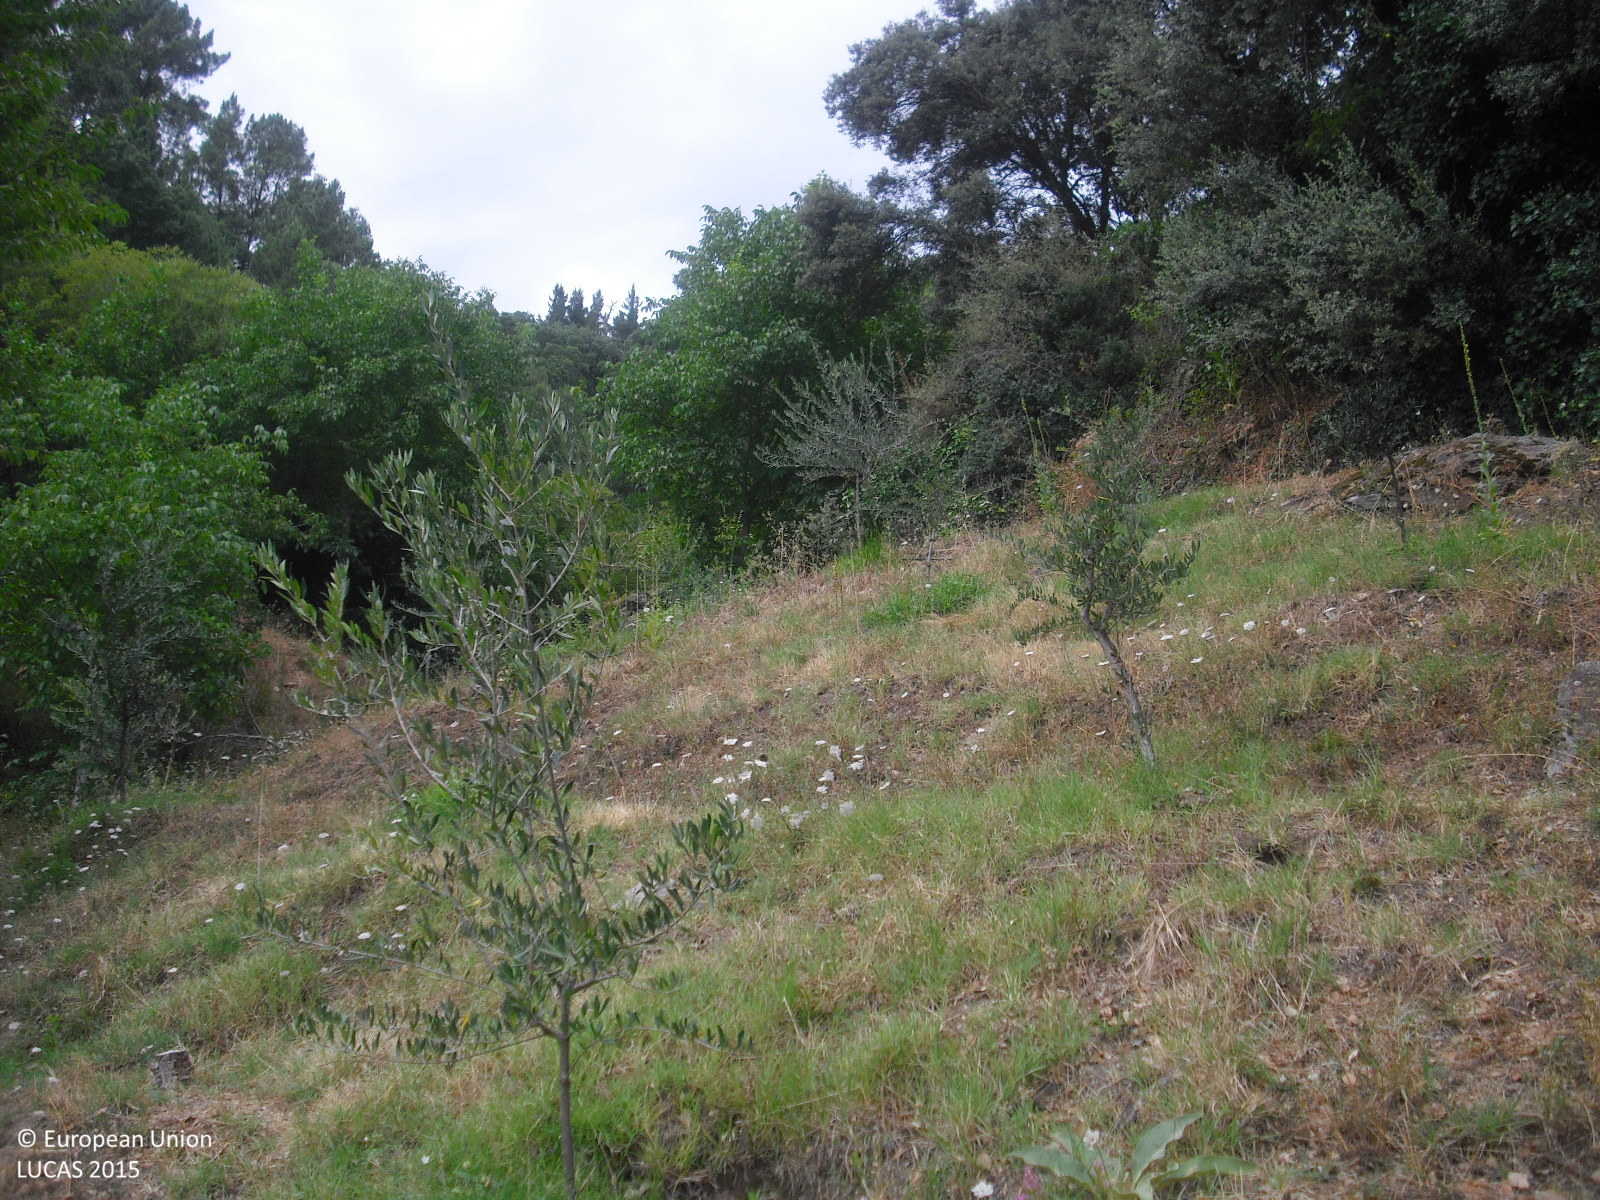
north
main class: Woodland
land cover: Broadleaved woodland
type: thermophilous deciduous forest
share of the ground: > 75 %
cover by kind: broadleaved forest trees 70 %, shrubs 30 %
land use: Semi-natural and natural areas not in use
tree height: > 5 m
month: July
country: ES
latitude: 42.4559
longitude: -7.2188
